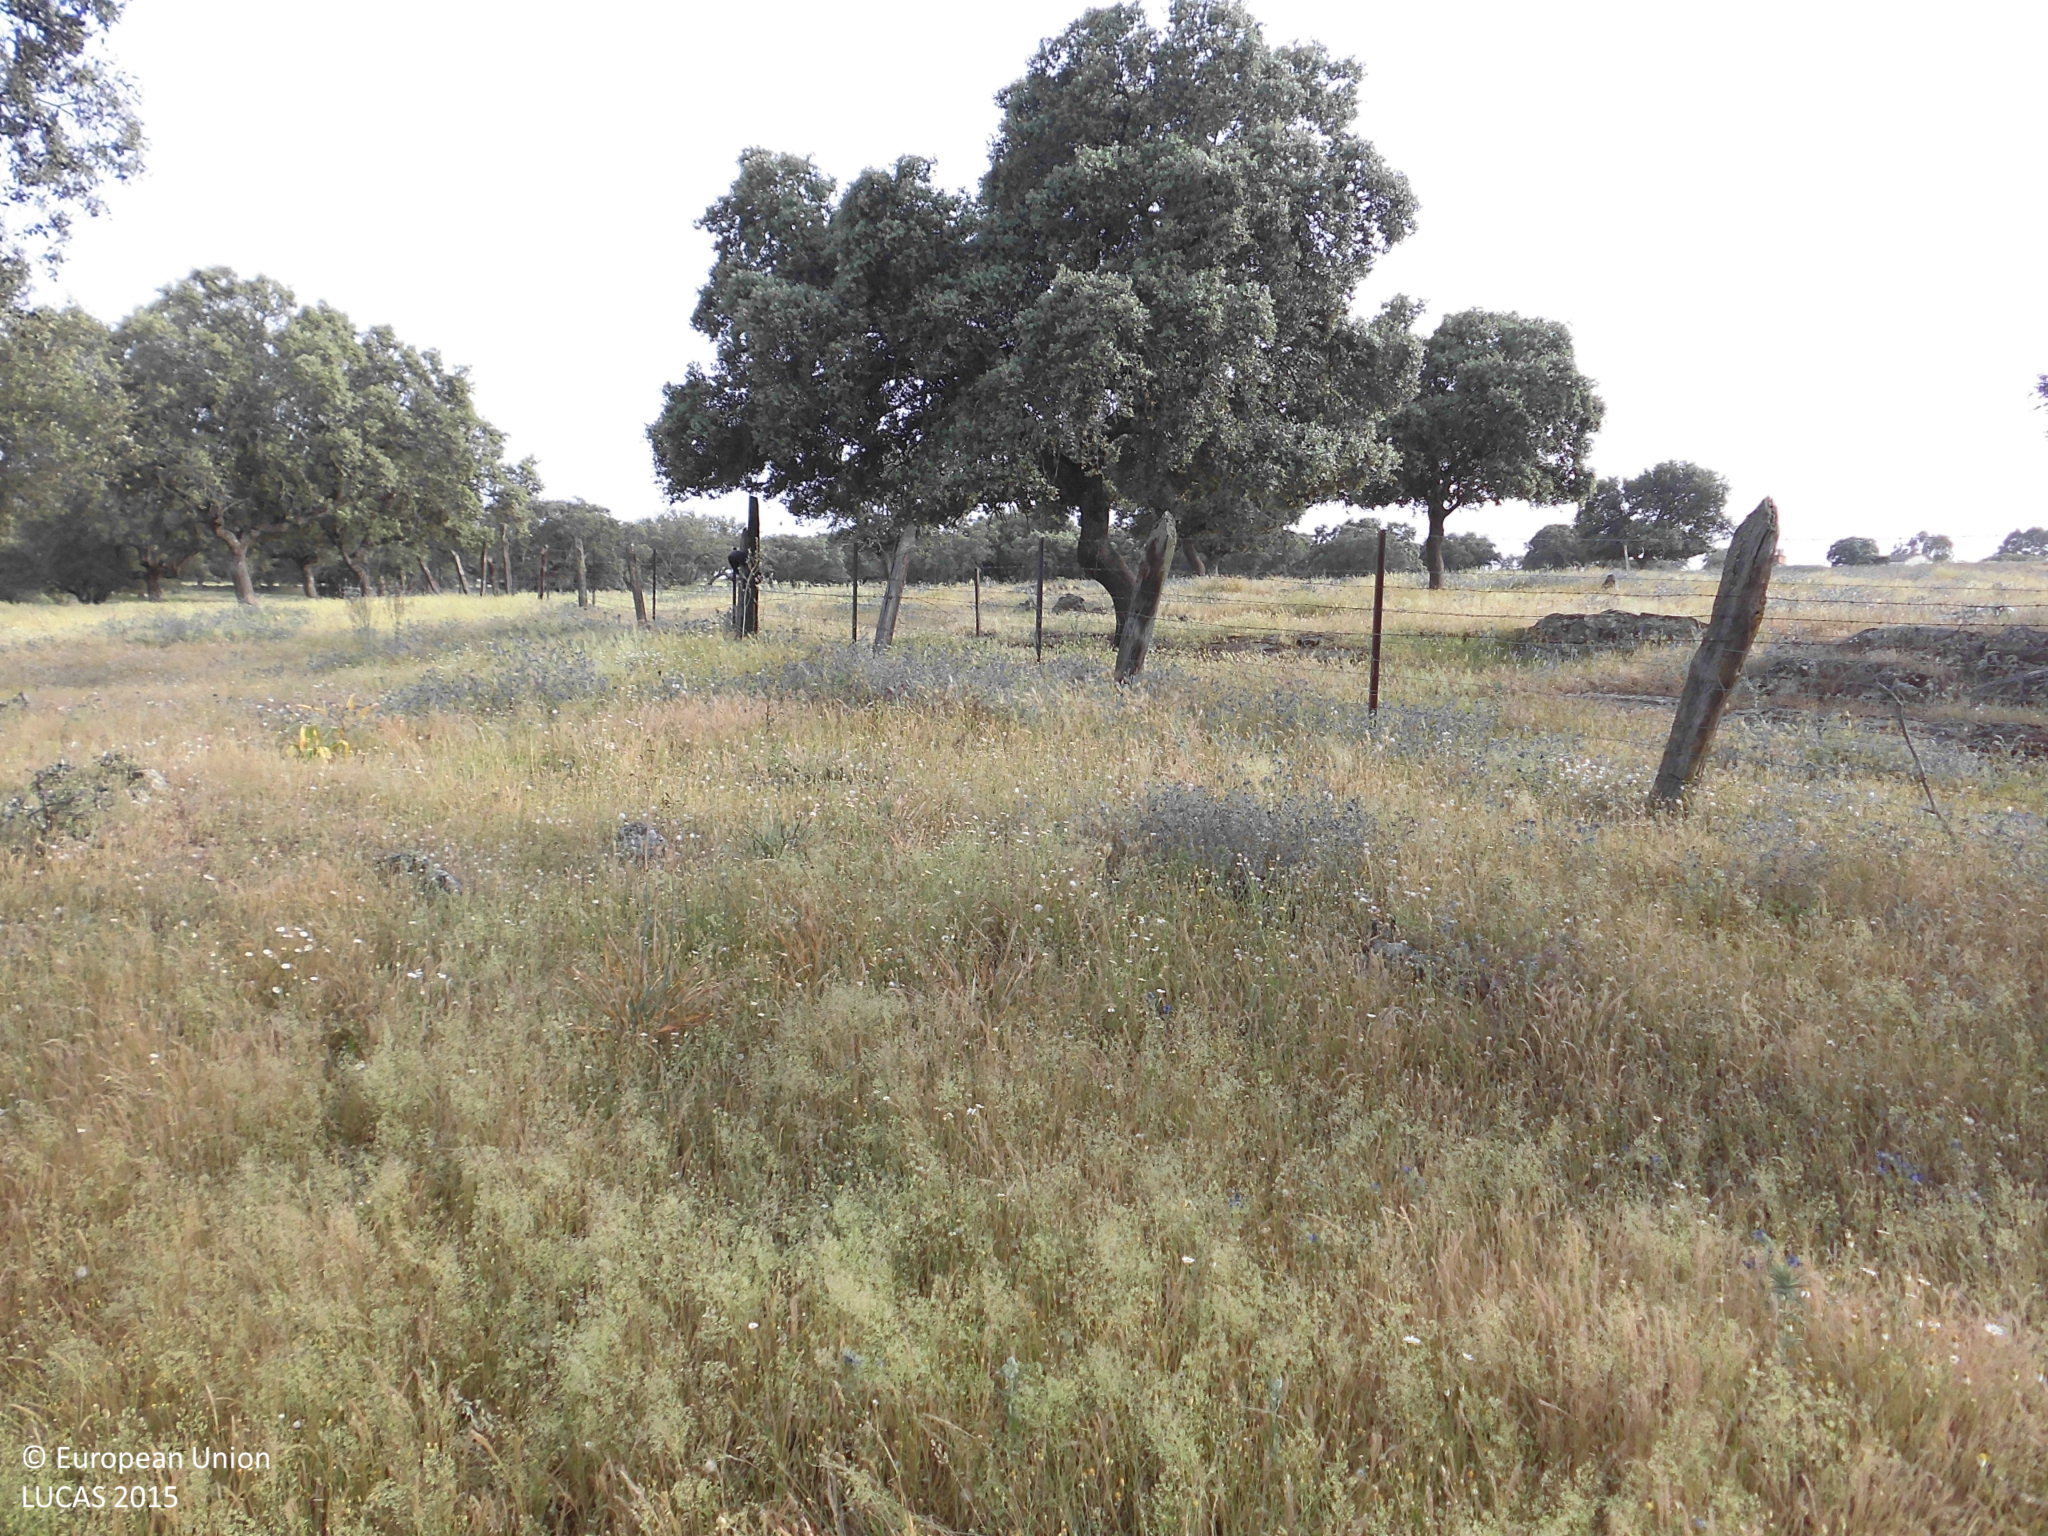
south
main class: Woodland
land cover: Broadleaved woodland
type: broadleaved evergreen forest
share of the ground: 25 - 50 %
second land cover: Grassland without tree/shrub cover
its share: > 75 %
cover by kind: shrubs 65 %, broadleaved forest trees 35 %
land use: Forestry
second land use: Agriculture (excluding fallow land and kitchen gardens)
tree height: > 5 m
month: May
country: ES
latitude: 39.6475
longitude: -6.0889
